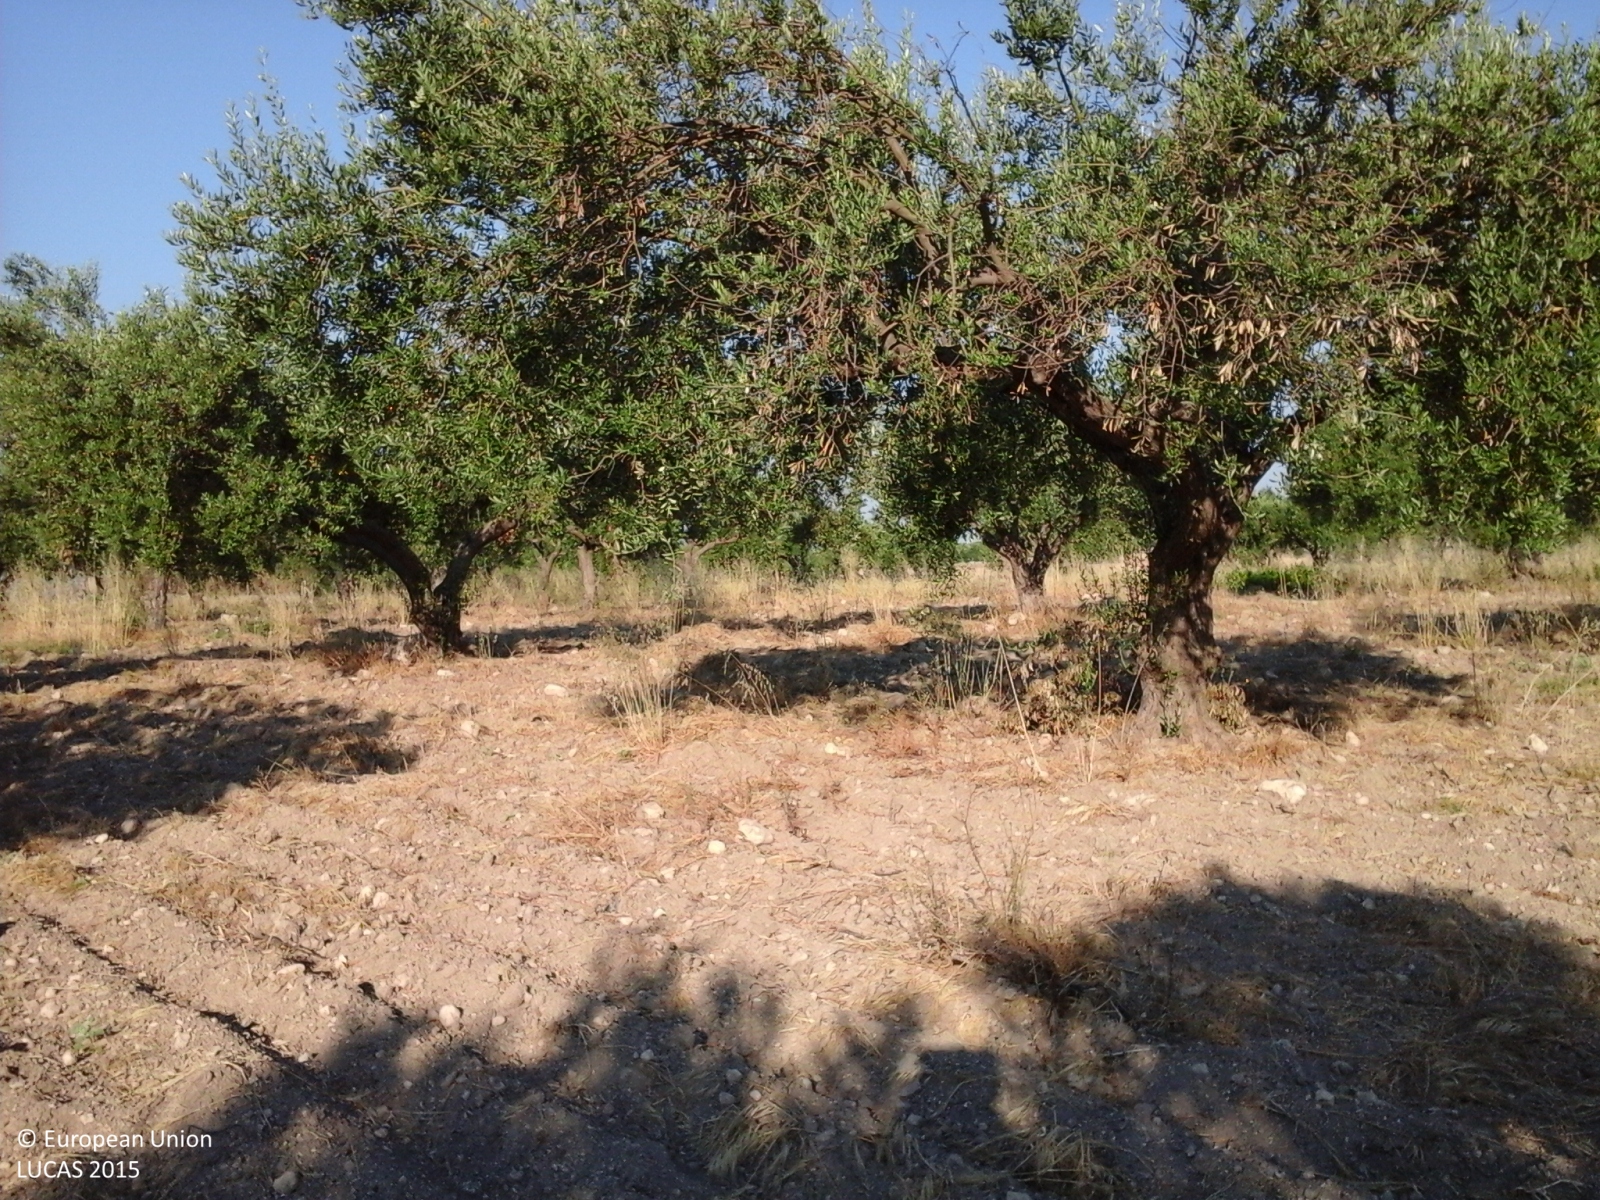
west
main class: Cropland
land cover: Olive groves
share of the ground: > 75 %
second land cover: Other bare soil
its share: > 75 %
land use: Agriculture (excluding fallow land and kitchen gardens)
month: July
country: IT
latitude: 37.1822
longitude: 13.7662
